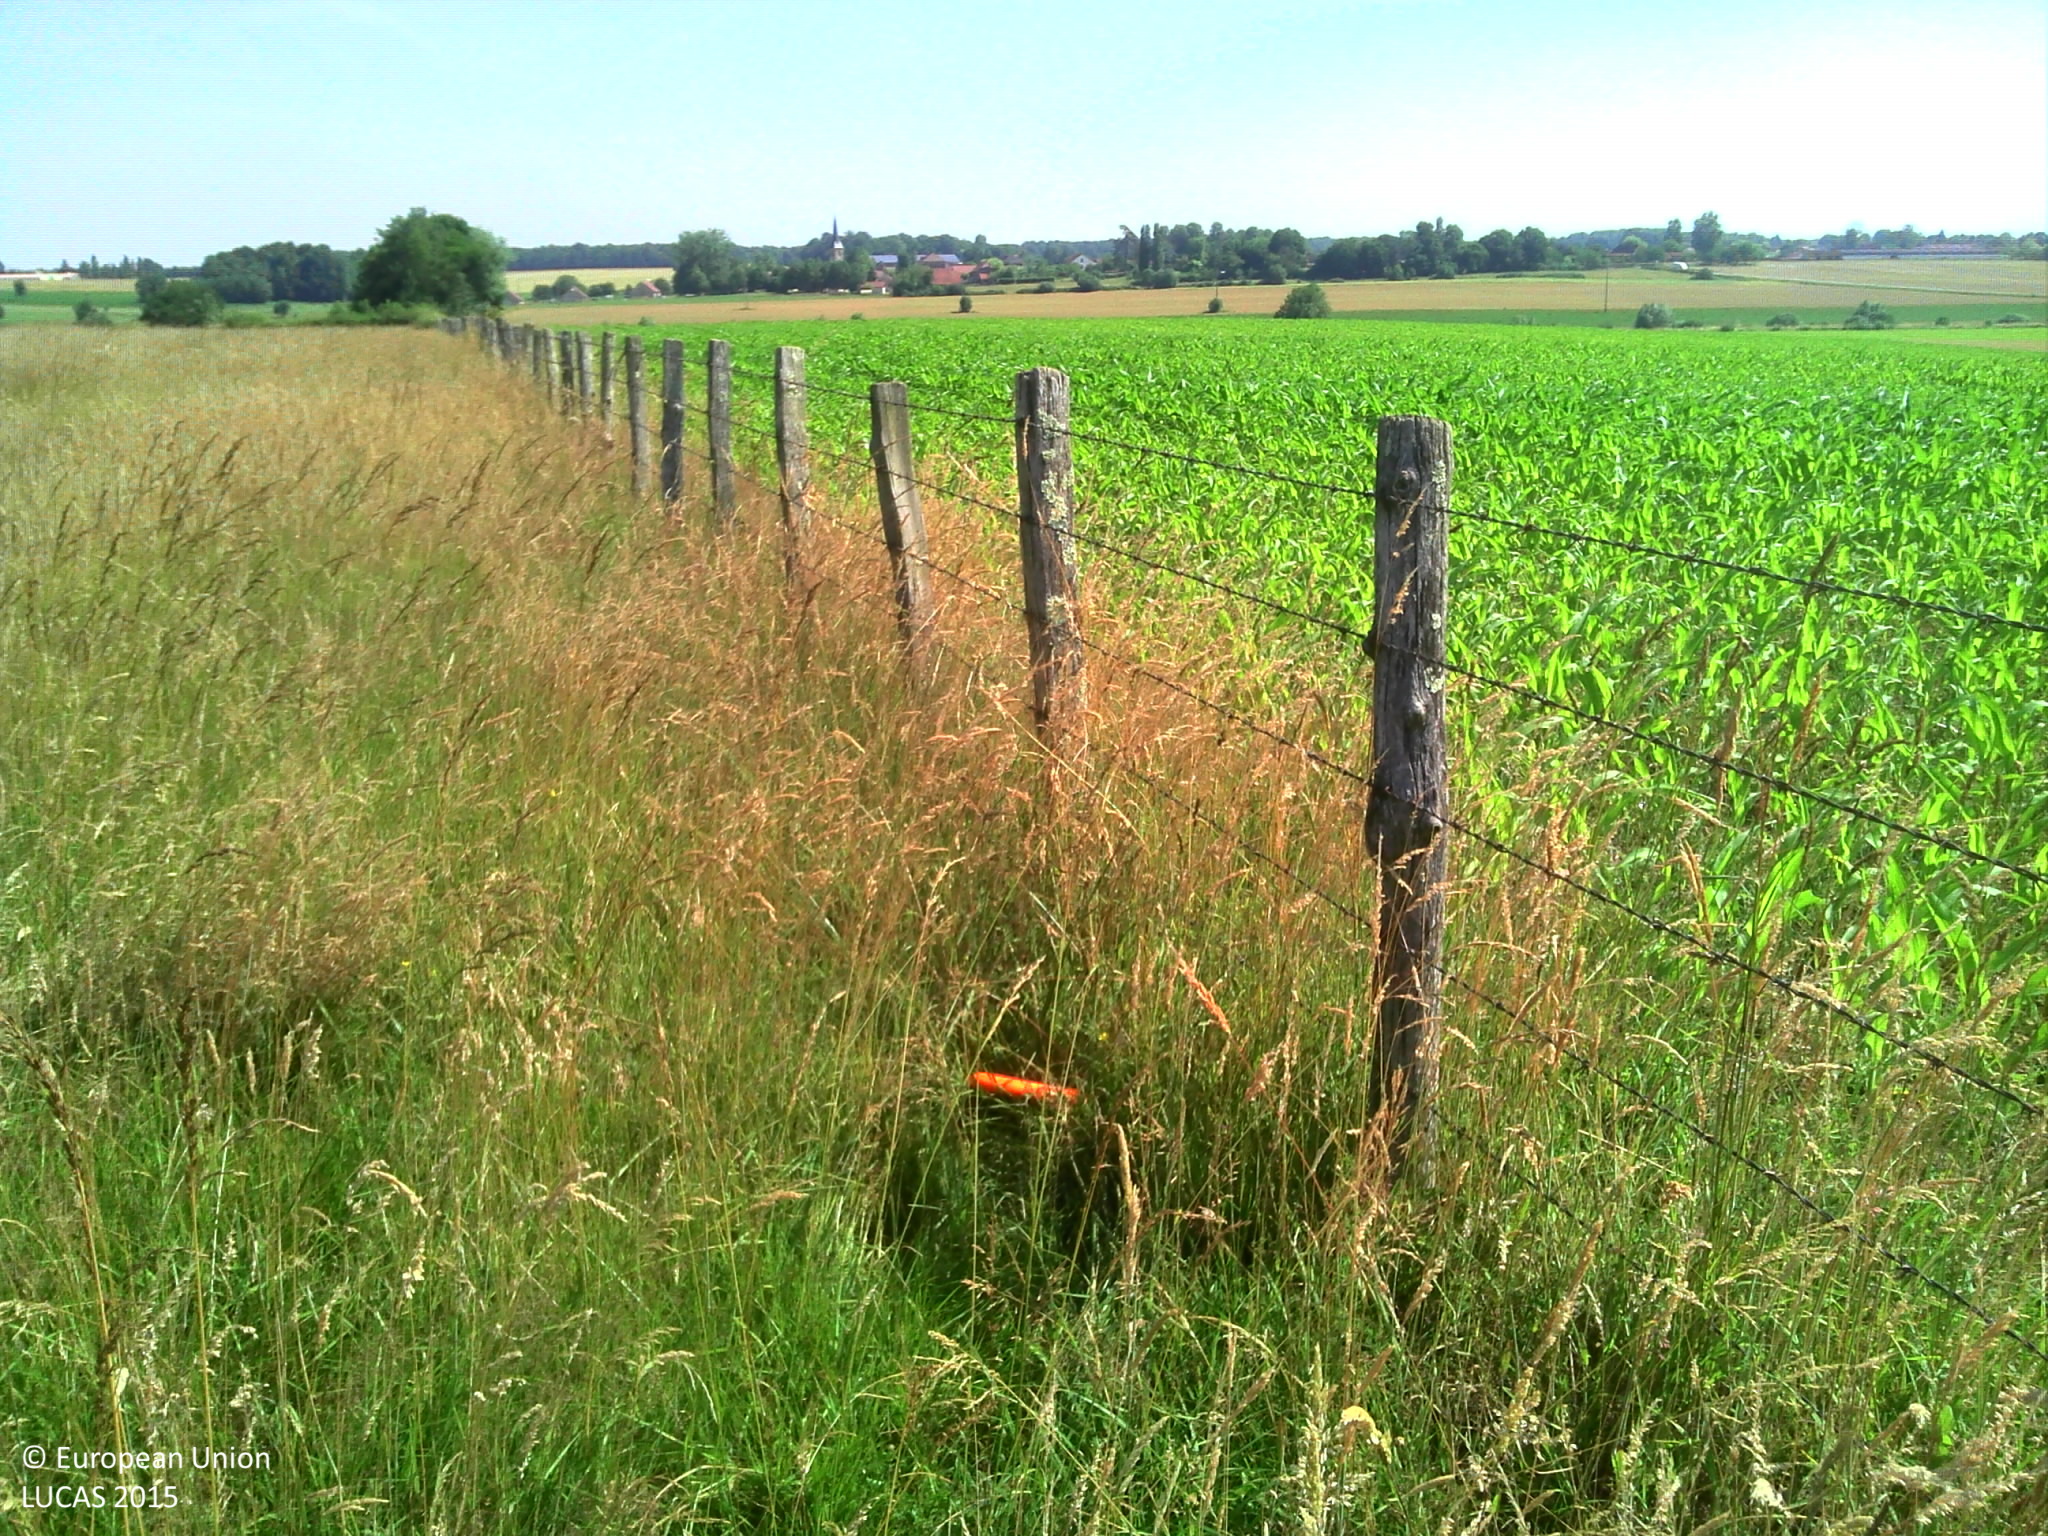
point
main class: Grassland
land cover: Grassland without tree/shrub cover
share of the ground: > 75 %
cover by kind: herbaceous plants 100 %
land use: Agriculture (excluding fallow land and kitchen gardens)
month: June
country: FR
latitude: 46.7543
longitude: 5.3284
